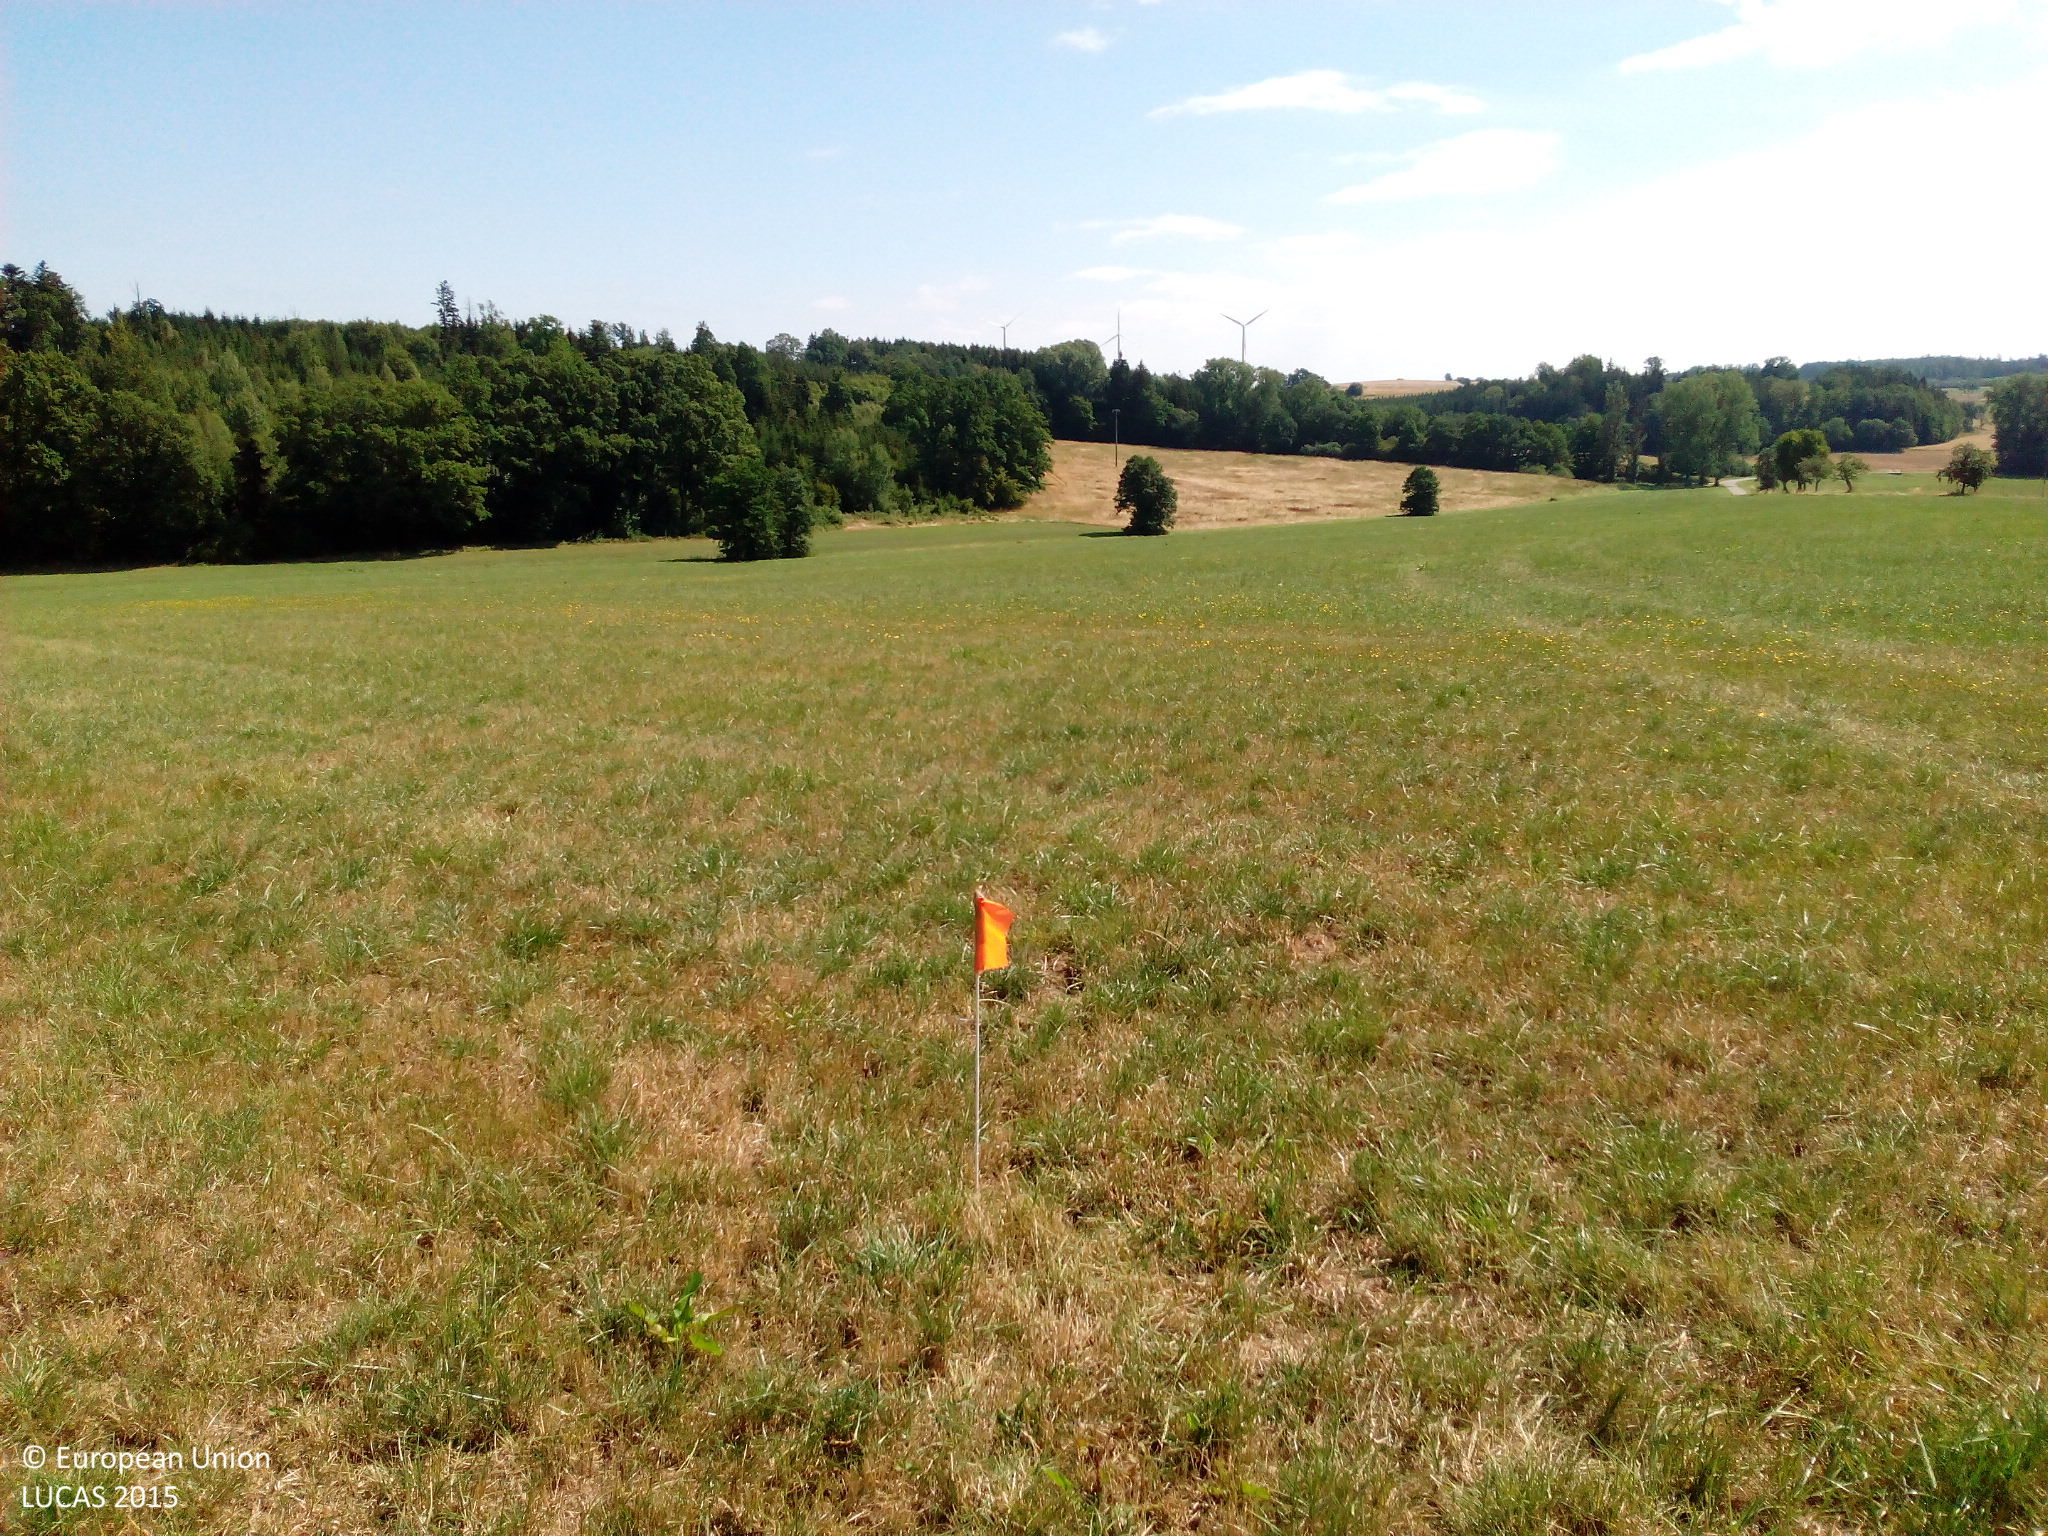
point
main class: Grassland
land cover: Grassland without tree/shrub cover
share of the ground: > 75 %
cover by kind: herbaceous plants 90 %, unconsolidated bare surface 10 %
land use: Agriculture (excluding fallow land and kitchen gardens)
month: August
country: DE
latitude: 48.9789
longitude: 10.2595
